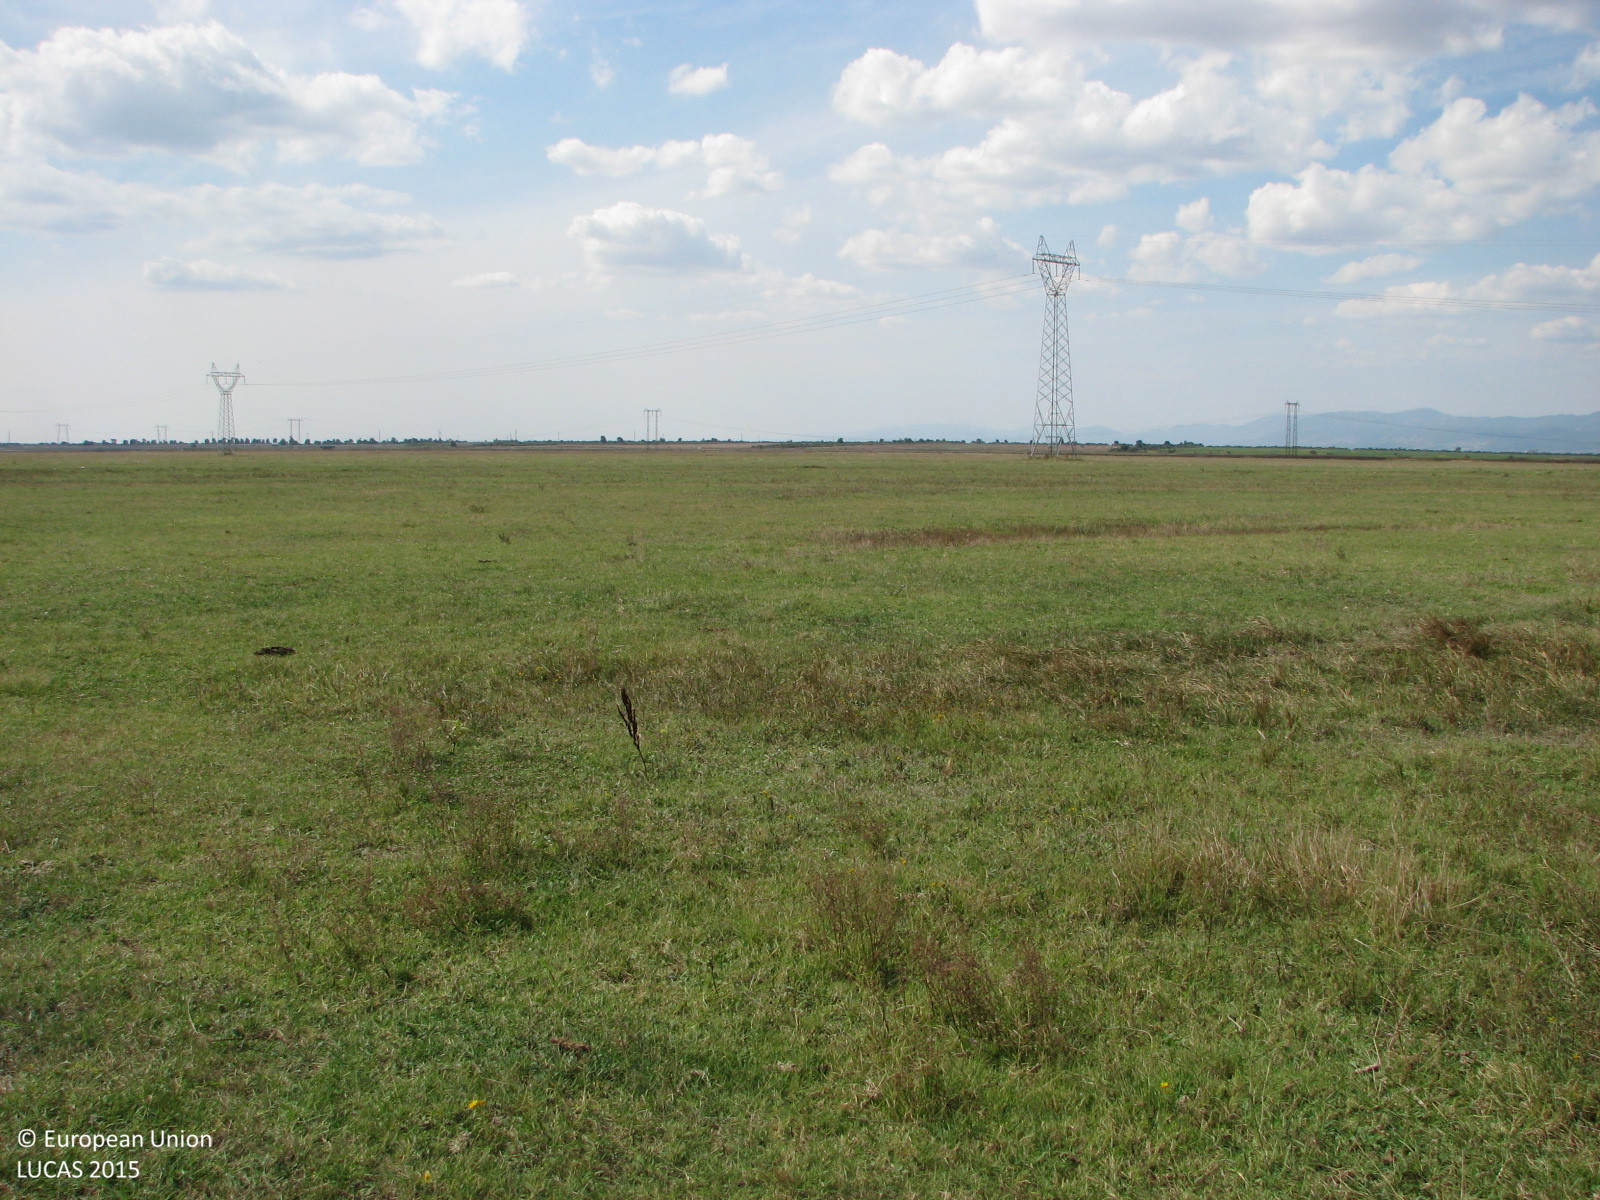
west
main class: Grassland
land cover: Grassland without tree/shrub cover
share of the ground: > 75 %
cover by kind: herbaceous plants 100 %
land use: Agriculture (excluding fallow land and kitchen gardens)
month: September
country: BG
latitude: 42.5545
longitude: 26.7479
